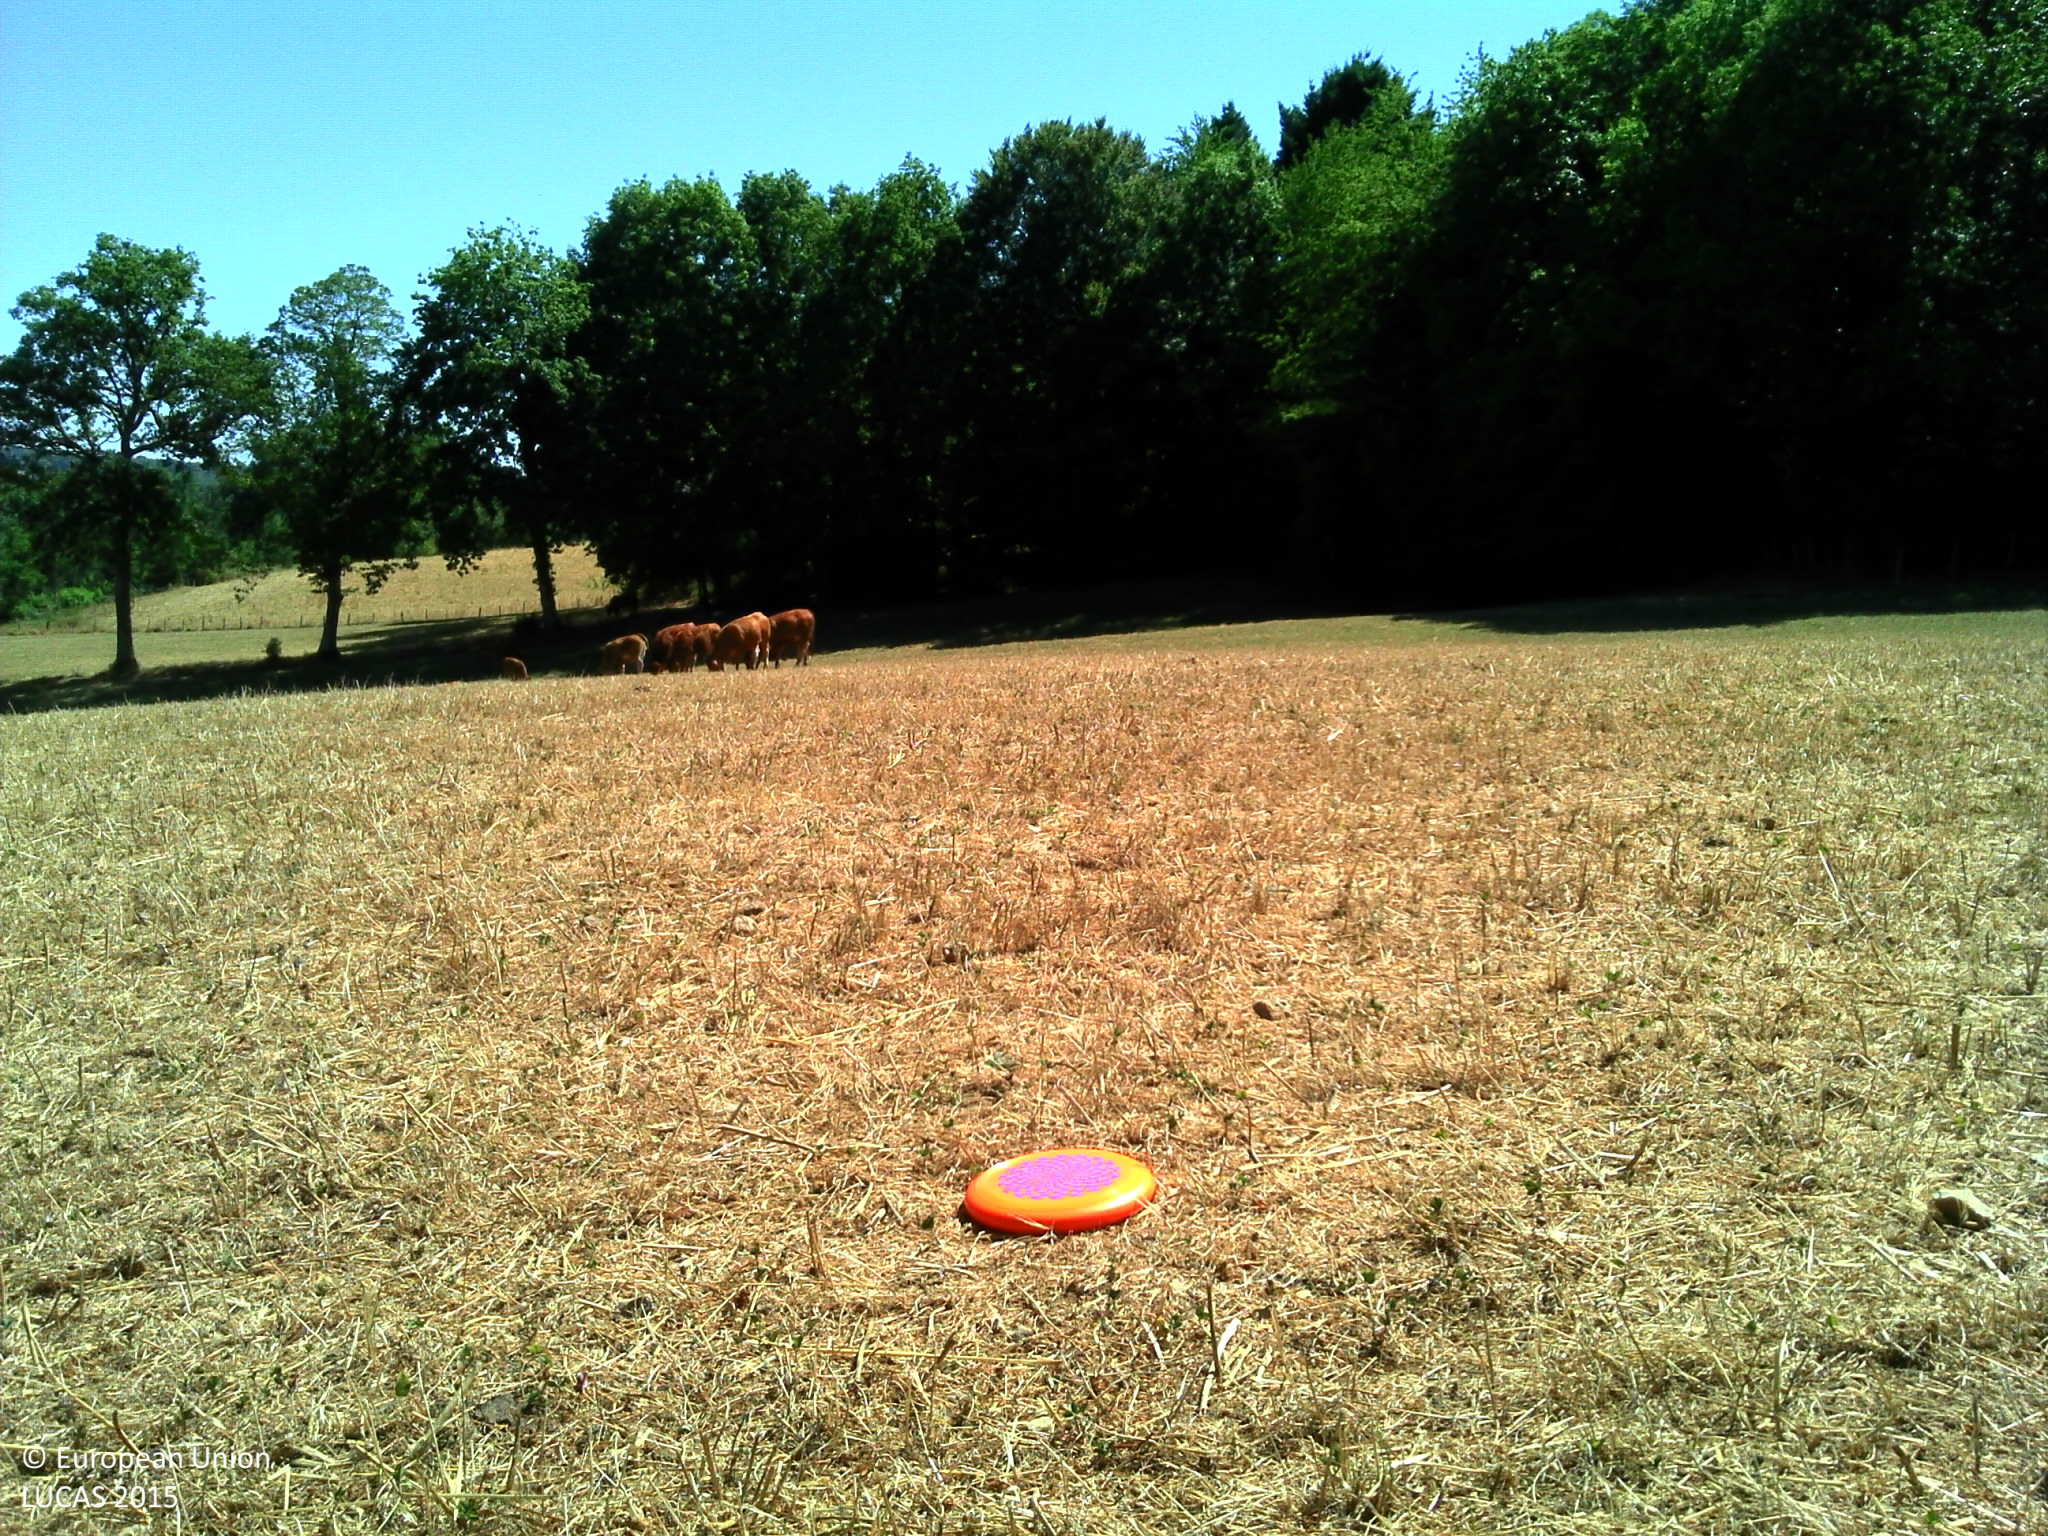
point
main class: Grassland
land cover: Grassland without tree/shrub cover
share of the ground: > 75 %
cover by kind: herbaceous plants 95 %
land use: Agriculture (excluding fallow land and kitchen gardens)
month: July
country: FR
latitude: 45.7722
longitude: 1.4404
